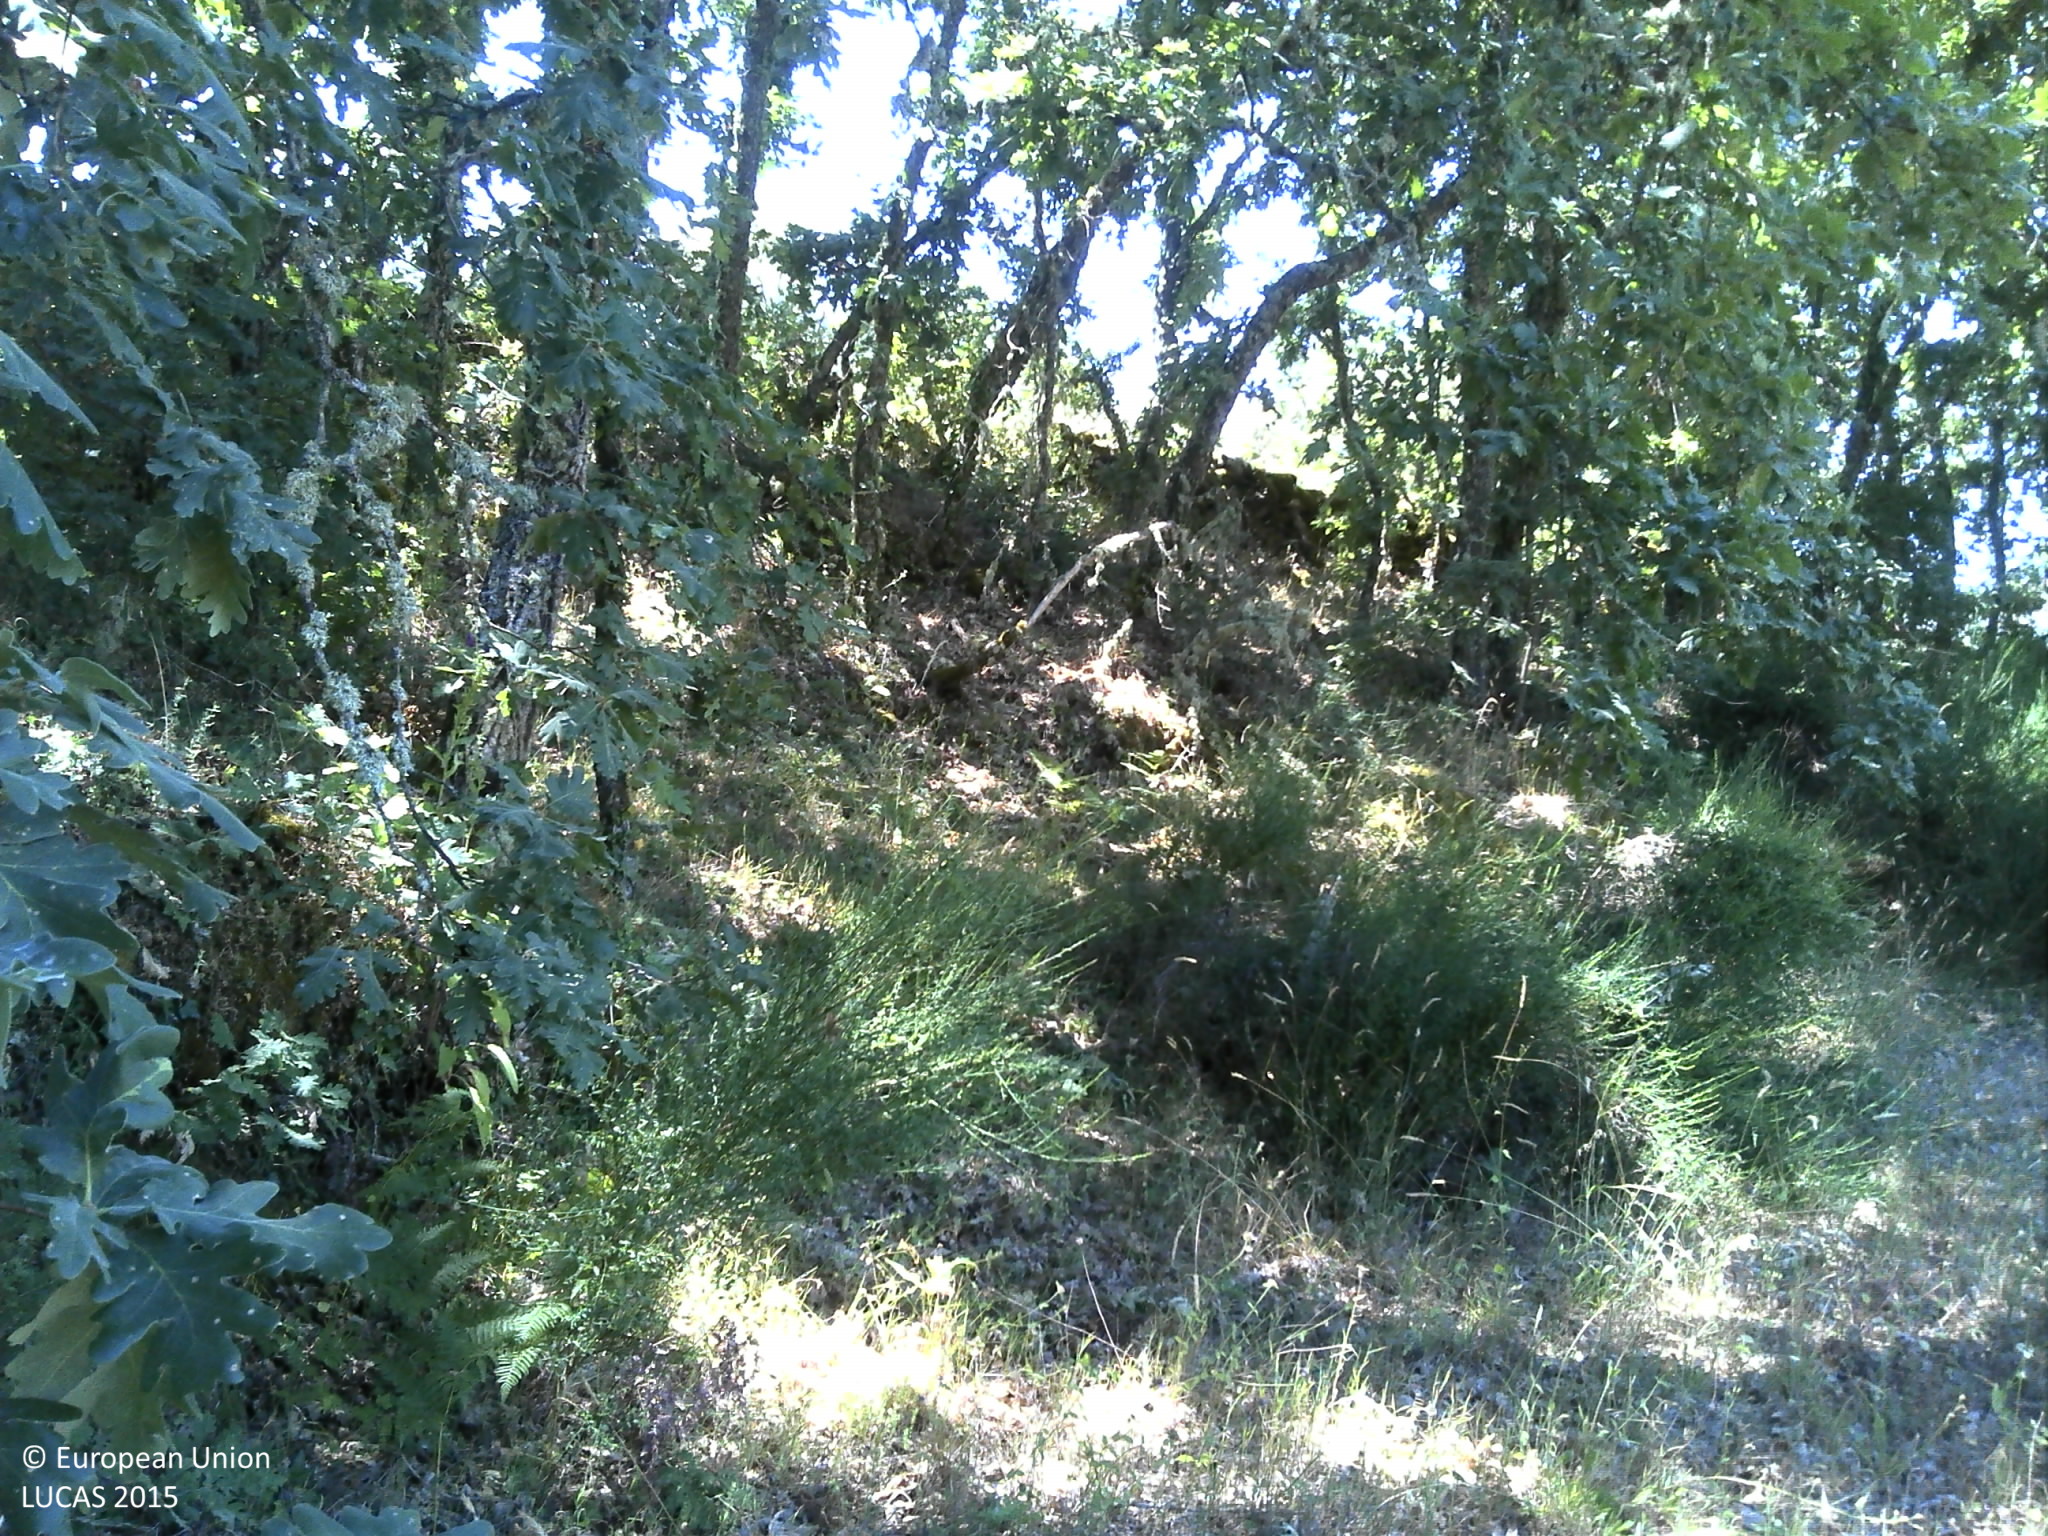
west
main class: Grassland
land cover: Spontaneously vegetated surfaces
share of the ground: > 75 %
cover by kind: herbaceous plants 95 %, unconsolidated bare surface 5 %
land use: Fallow land
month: June
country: PT
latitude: 40.7825
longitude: -7.3046
